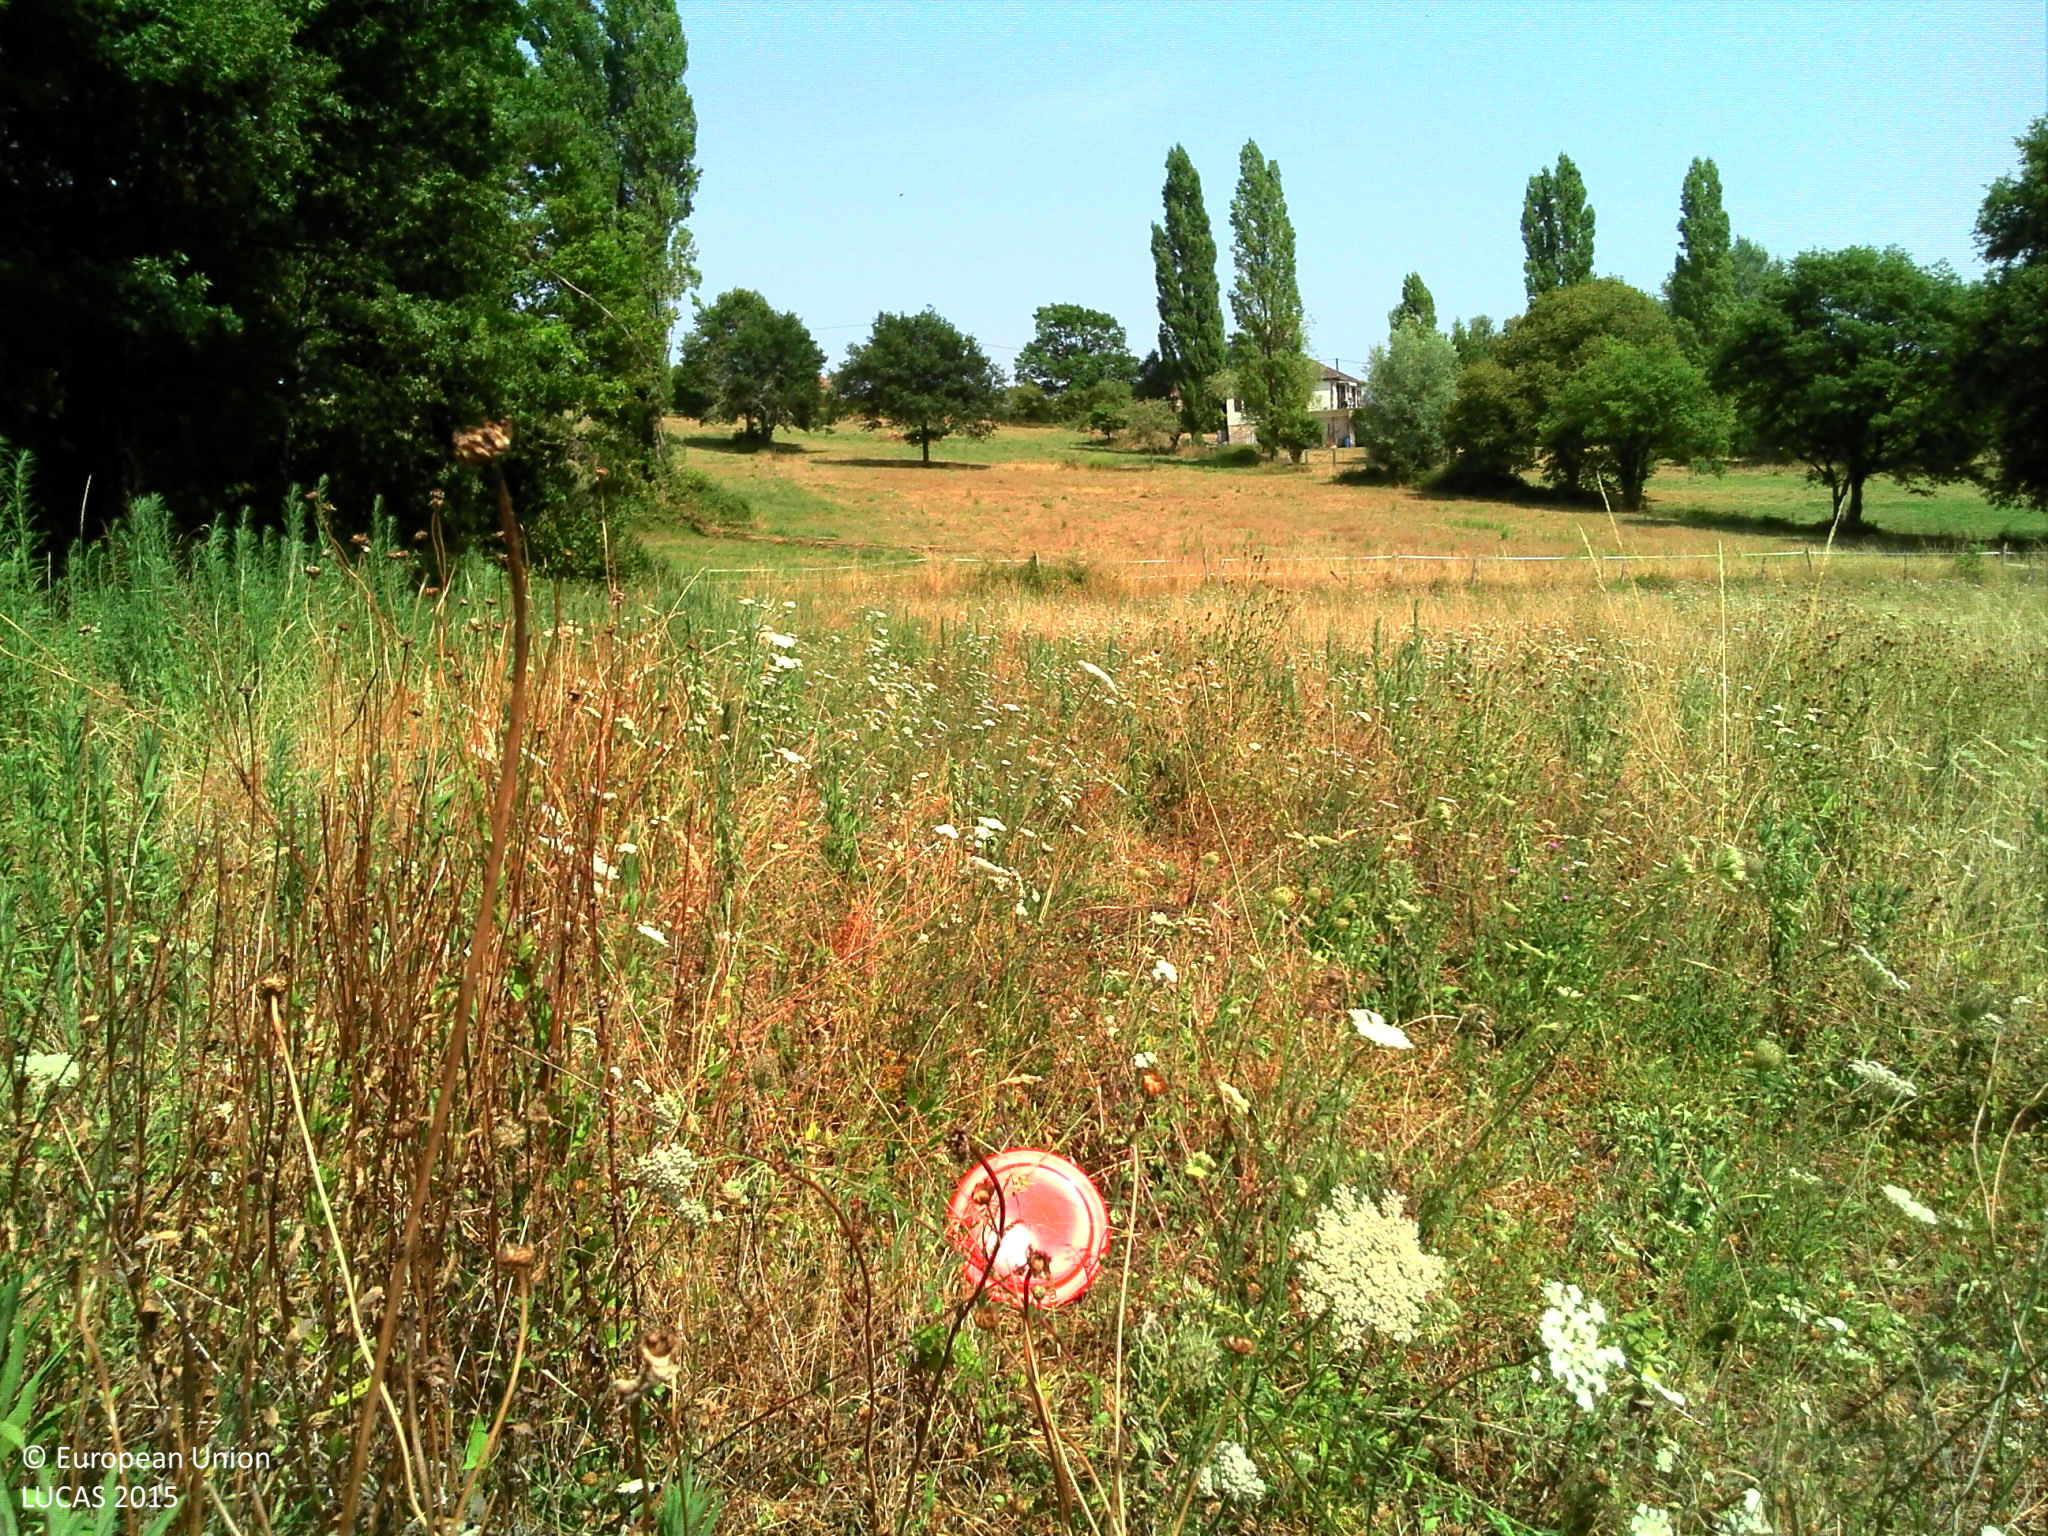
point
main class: Grassland
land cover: Grassland without tree/shrub cover
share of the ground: > 75 %
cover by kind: herbaceous plants 100 %
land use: Agriculture (excluding fallow land and kitchen gardens)
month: July
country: FR
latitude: 45.1527
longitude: 1.1785
